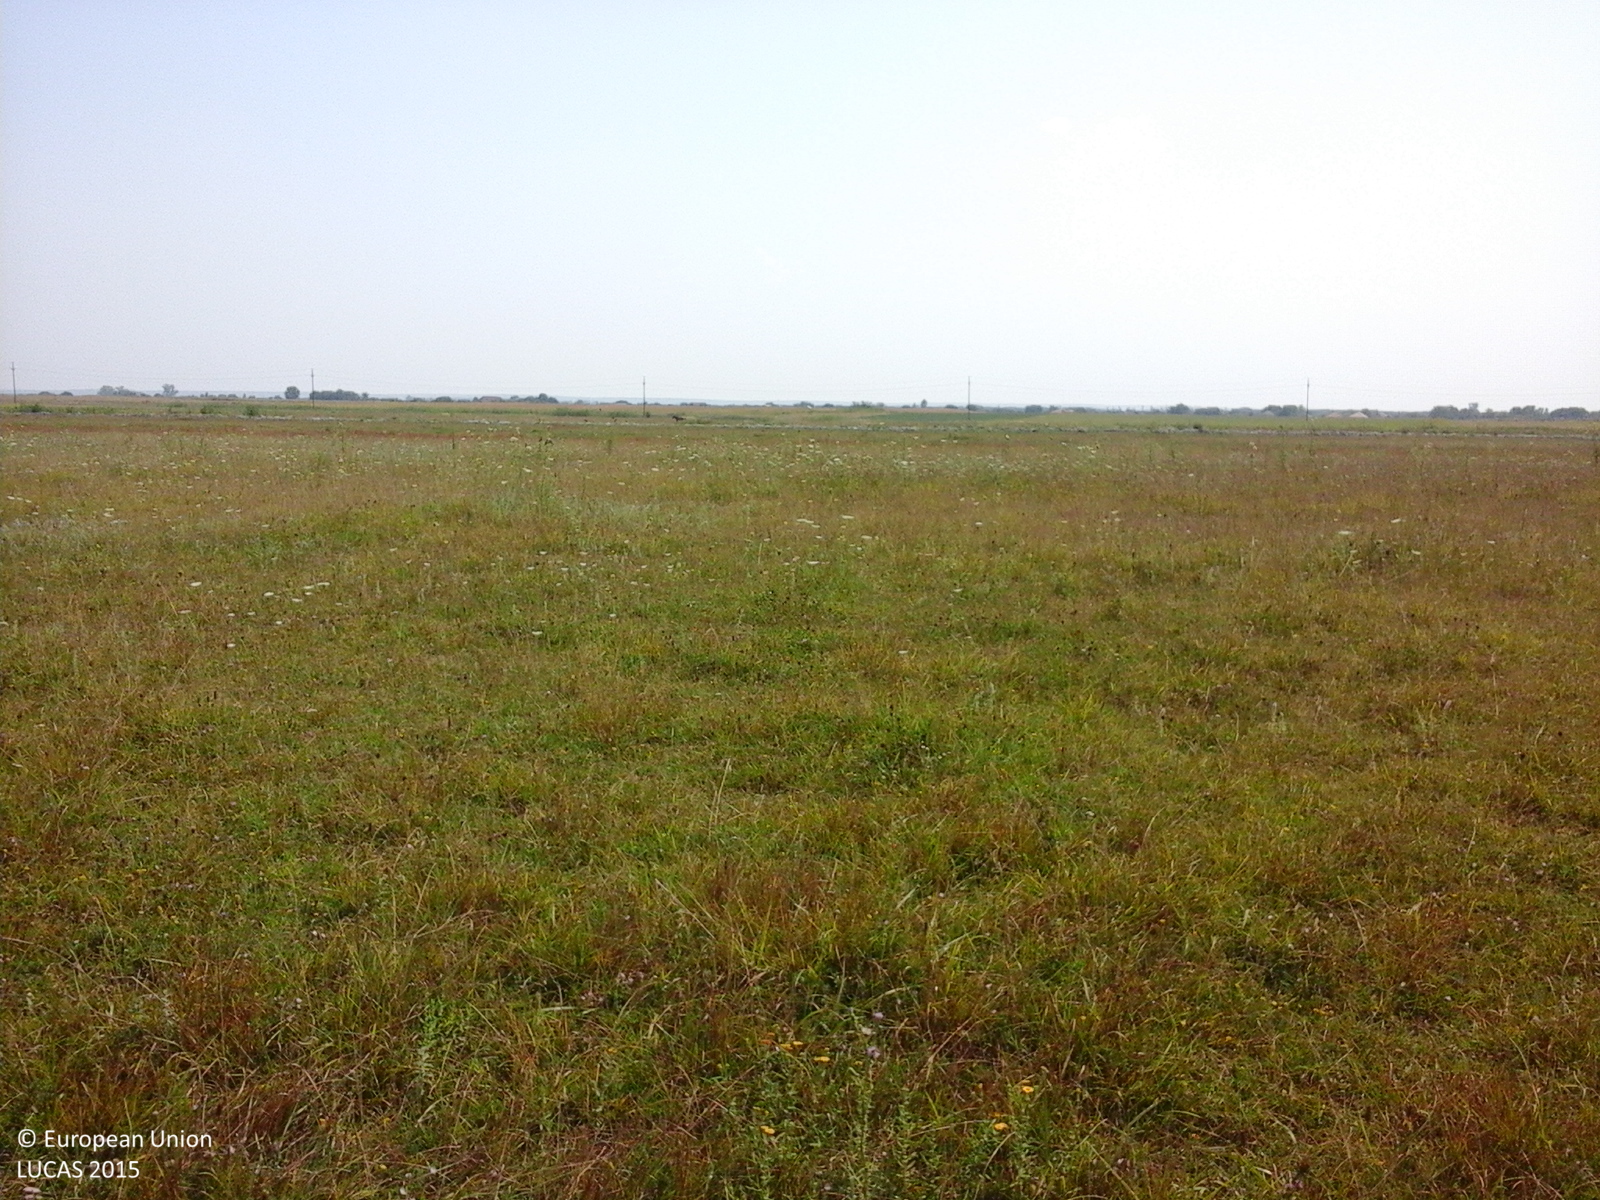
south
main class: Grassland
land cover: Grassland without tree/shrub cover
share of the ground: > 75 %
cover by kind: herbaceous plants 100 %
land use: Agriculture (excluding fallow land and kitchen gardens)
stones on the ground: < 10 %
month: August
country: RO
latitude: 43.9074
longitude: 23.1797
